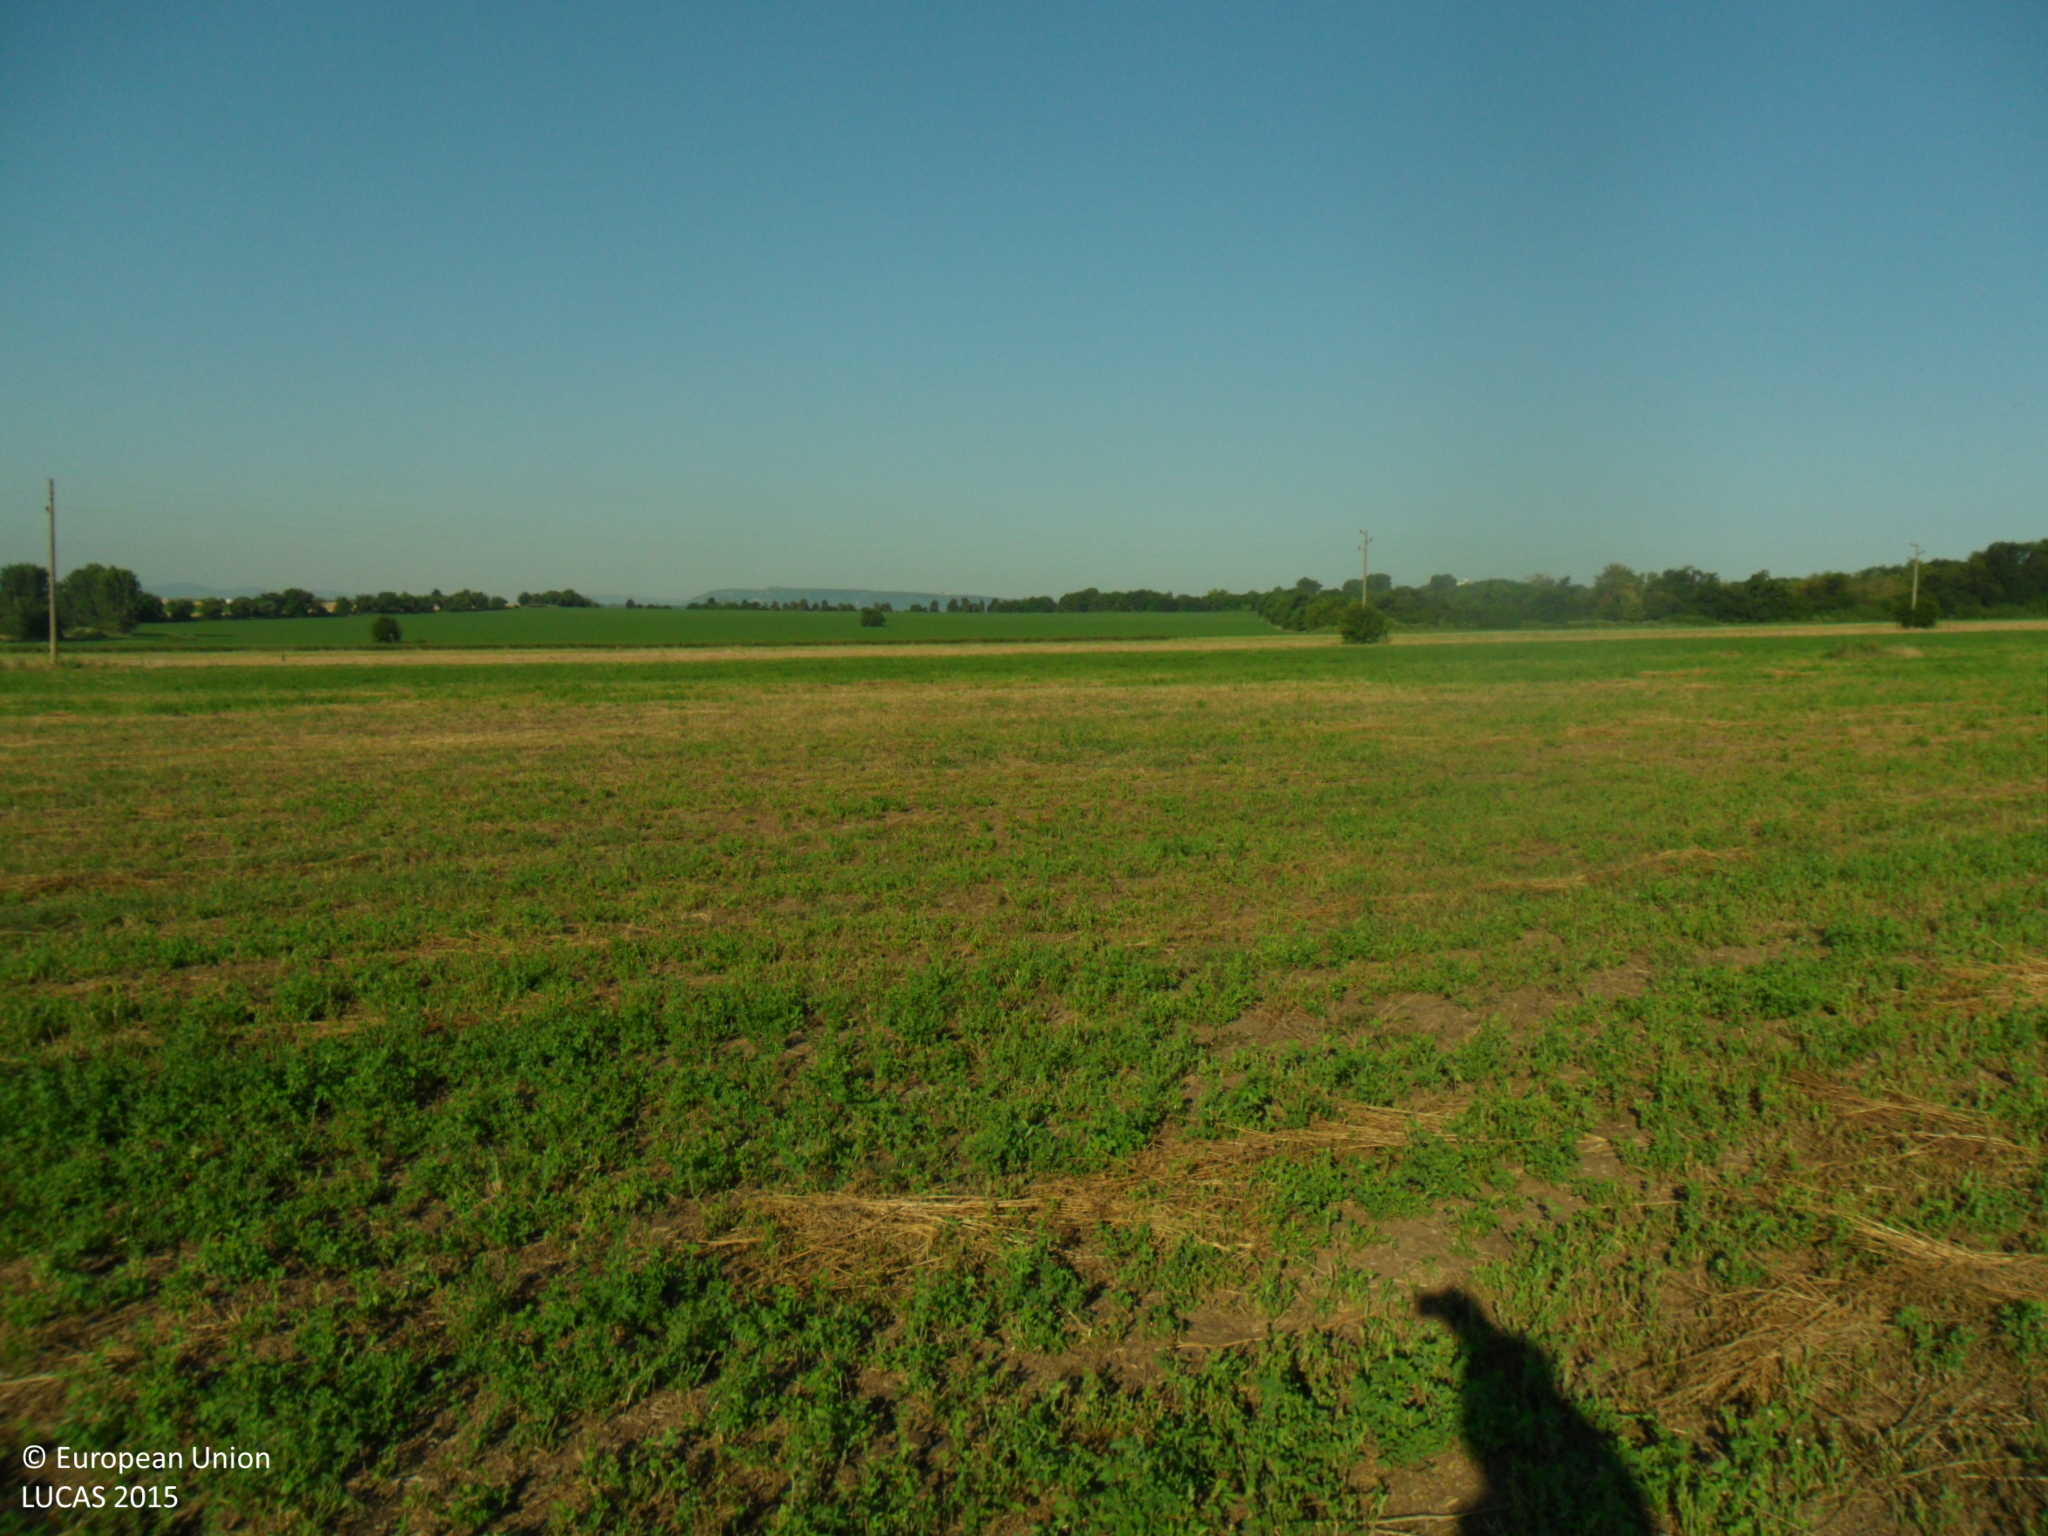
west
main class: Cropland
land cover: Lucerne
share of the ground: > 75 %
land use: Agriculture (excluding fallow land and kitchen gardens)
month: June
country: BG
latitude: 43.3141
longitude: 27.0450
